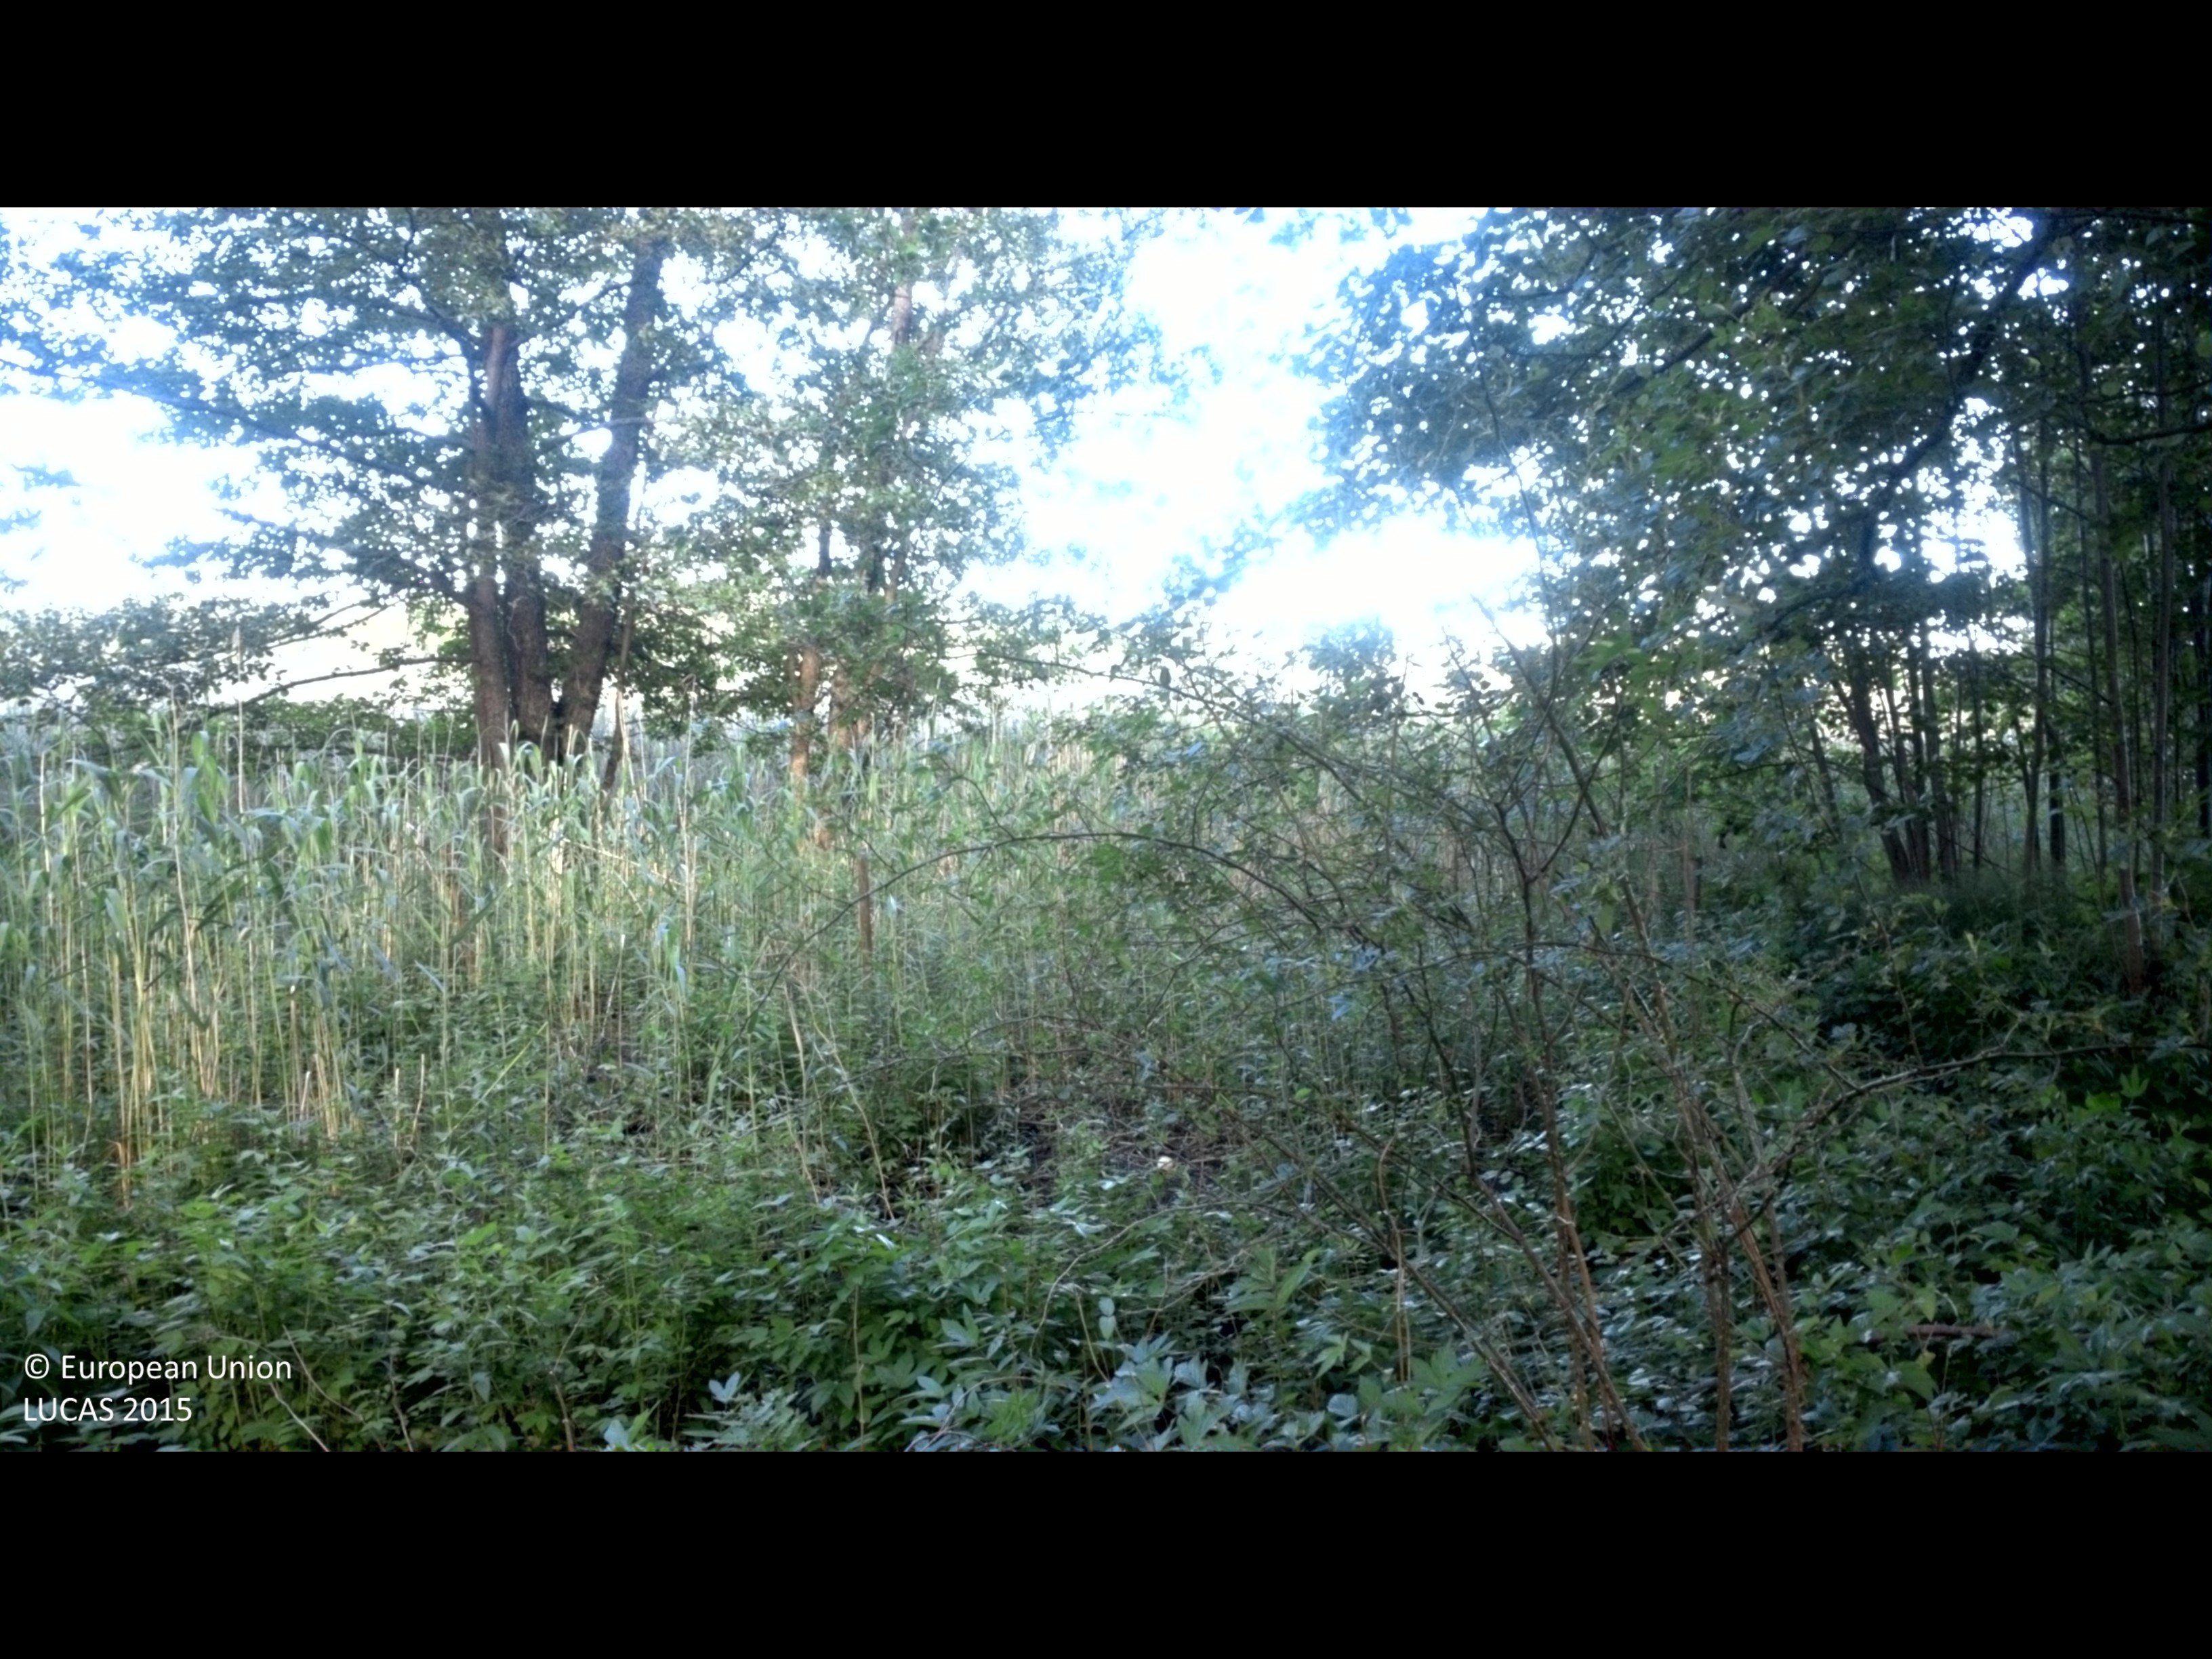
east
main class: Woodland
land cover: Broadleaved woodland
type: hemiboreal forest and nemoral coniferous forest and mixed broadleaved-coniferous forest
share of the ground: > 75 %
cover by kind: broadleaved forest trees 75 %, herbaceous plants 20 %, shrubs 5 %
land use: Forestry
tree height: > 5 m
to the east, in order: Broadleaved woodland
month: June
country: SE
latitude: 57.7649
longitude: 16.6722
